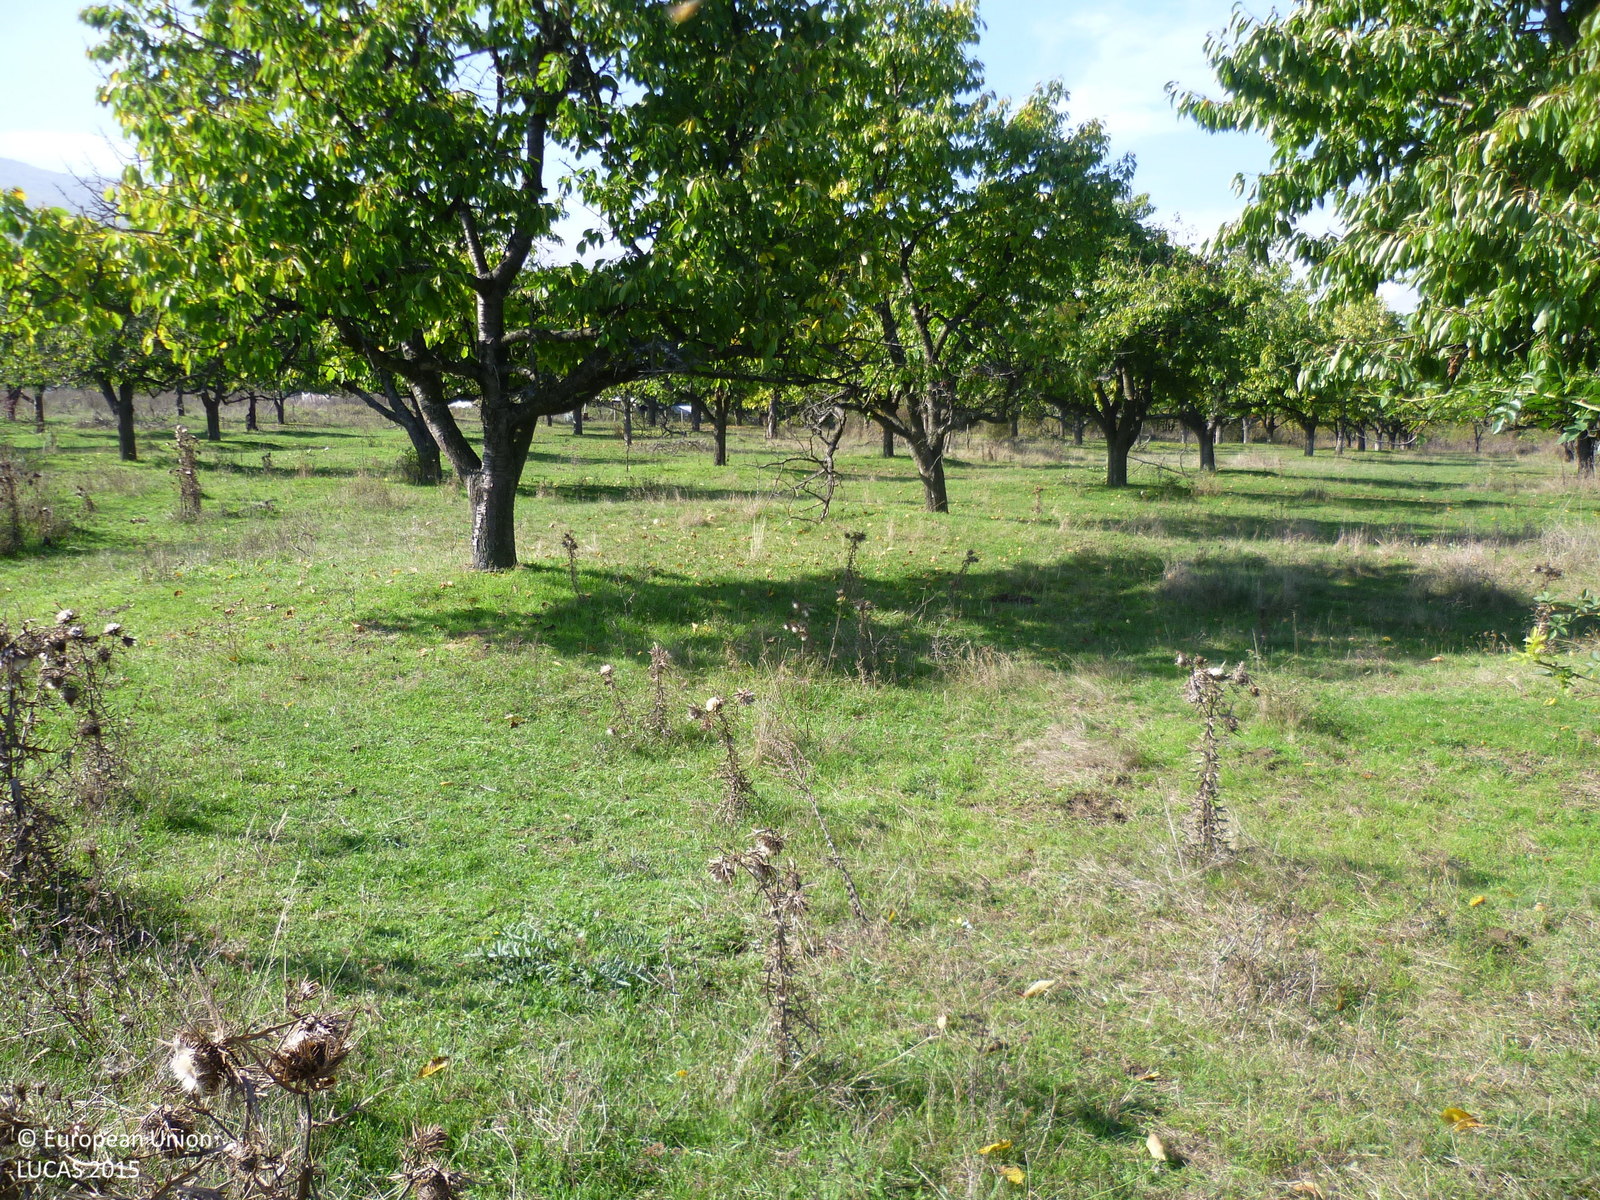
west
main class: Cropland
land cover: Cherry fruit
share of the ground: 50 - 75 %
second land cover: Grassland without tree/shrub cover
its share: > 75 %
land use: Agriculture (excluding fallow land and kitchen gardens)
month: October
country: BG
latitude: 42.4266
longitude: 23.7356
